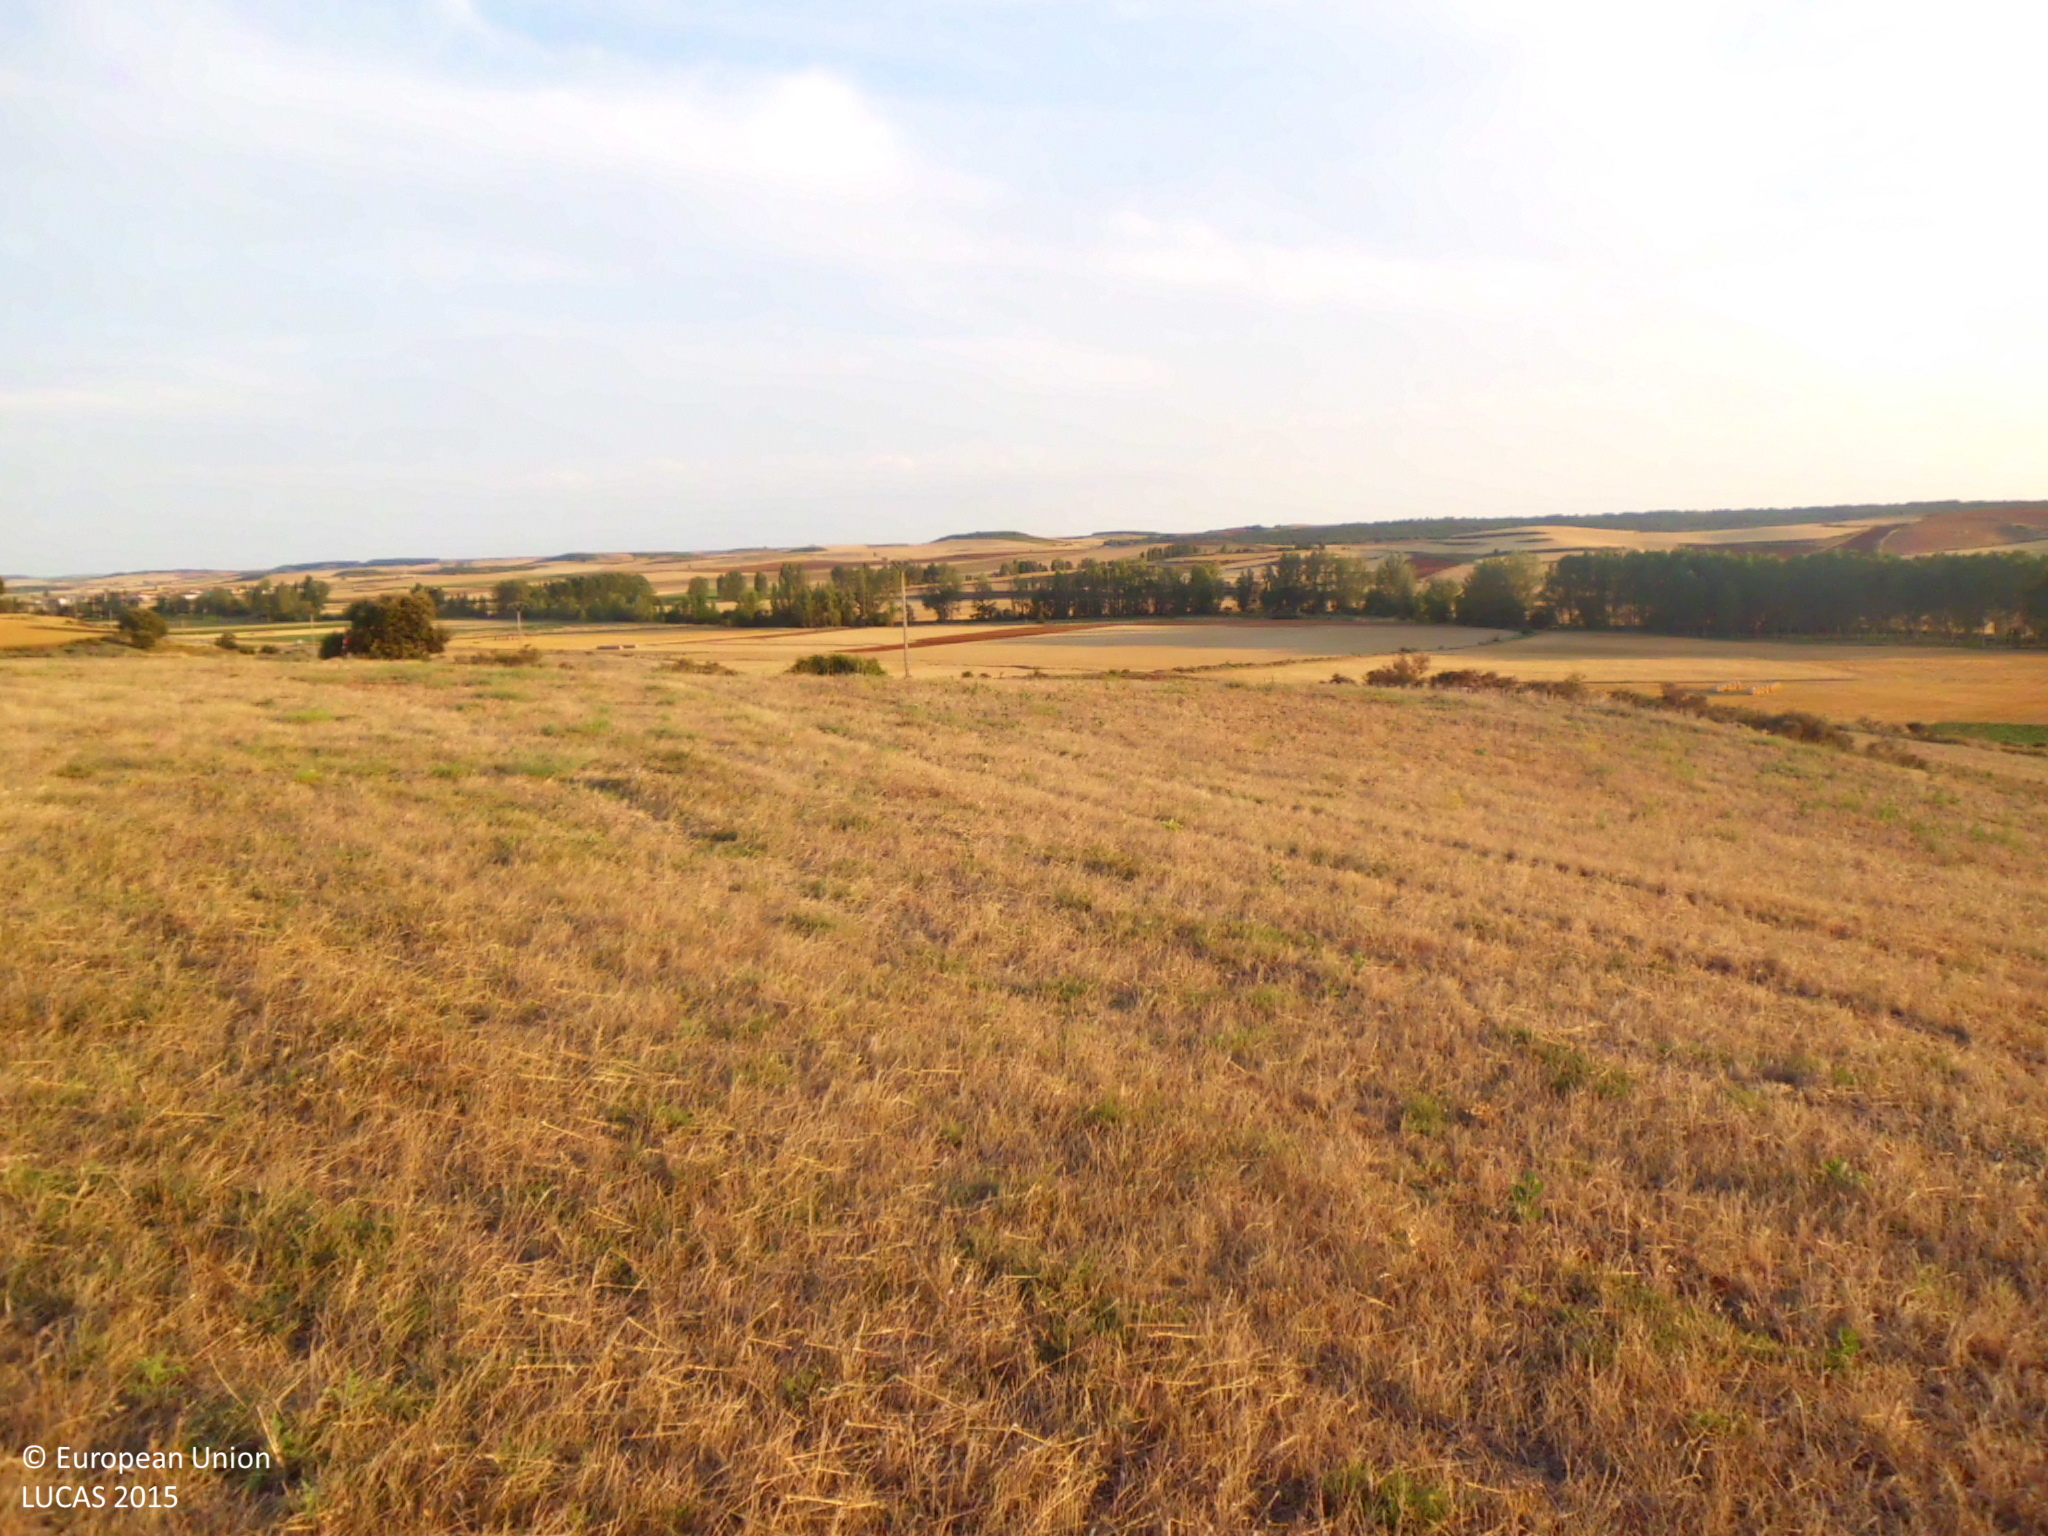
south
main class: Grassland
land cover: Spontaneously vegetated surfaces
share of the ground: > 75 %
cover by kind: herbaceous plants 100 %
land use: Fallow land
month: July
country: ES
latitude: 42.6824
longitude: -4.3909
